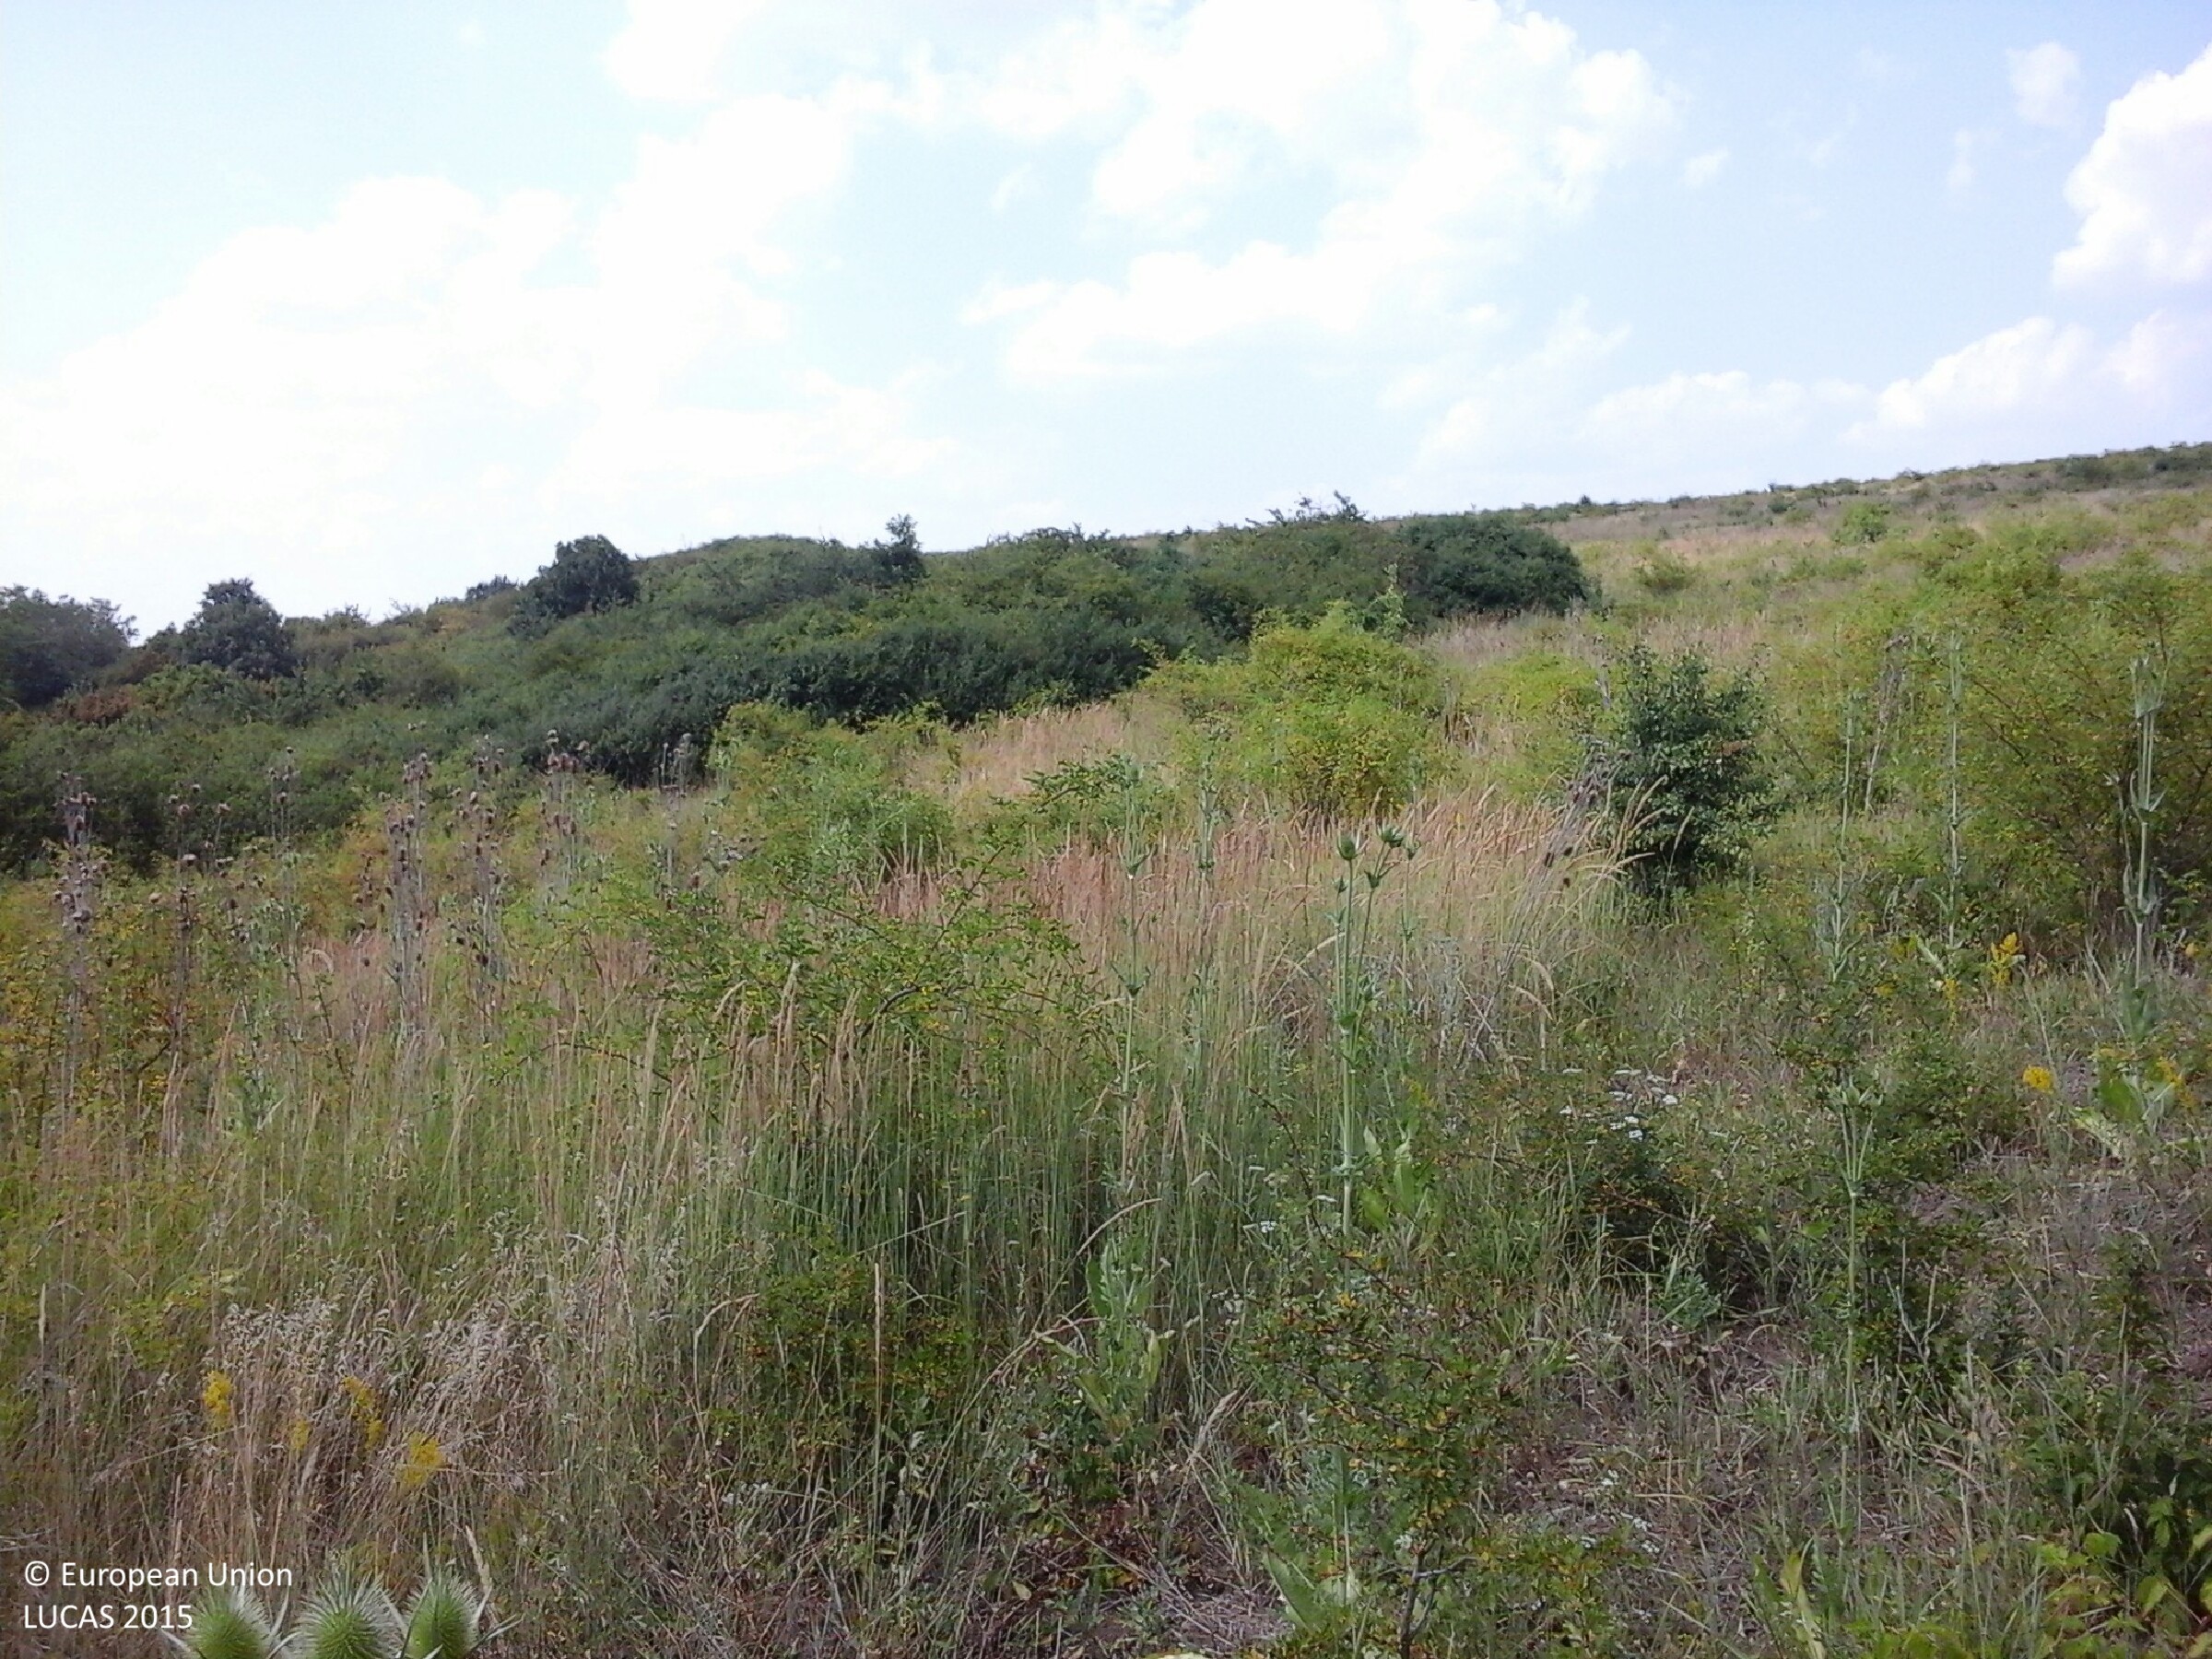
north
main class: Shrubland
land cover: Shrubland without tree cover
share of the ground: 50 - 75 %
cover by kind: shrubs 50 %, herbaceous plants 50 %
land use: Abandoned areas
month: July
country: HU
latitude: 47.8455
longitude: 20.3335
